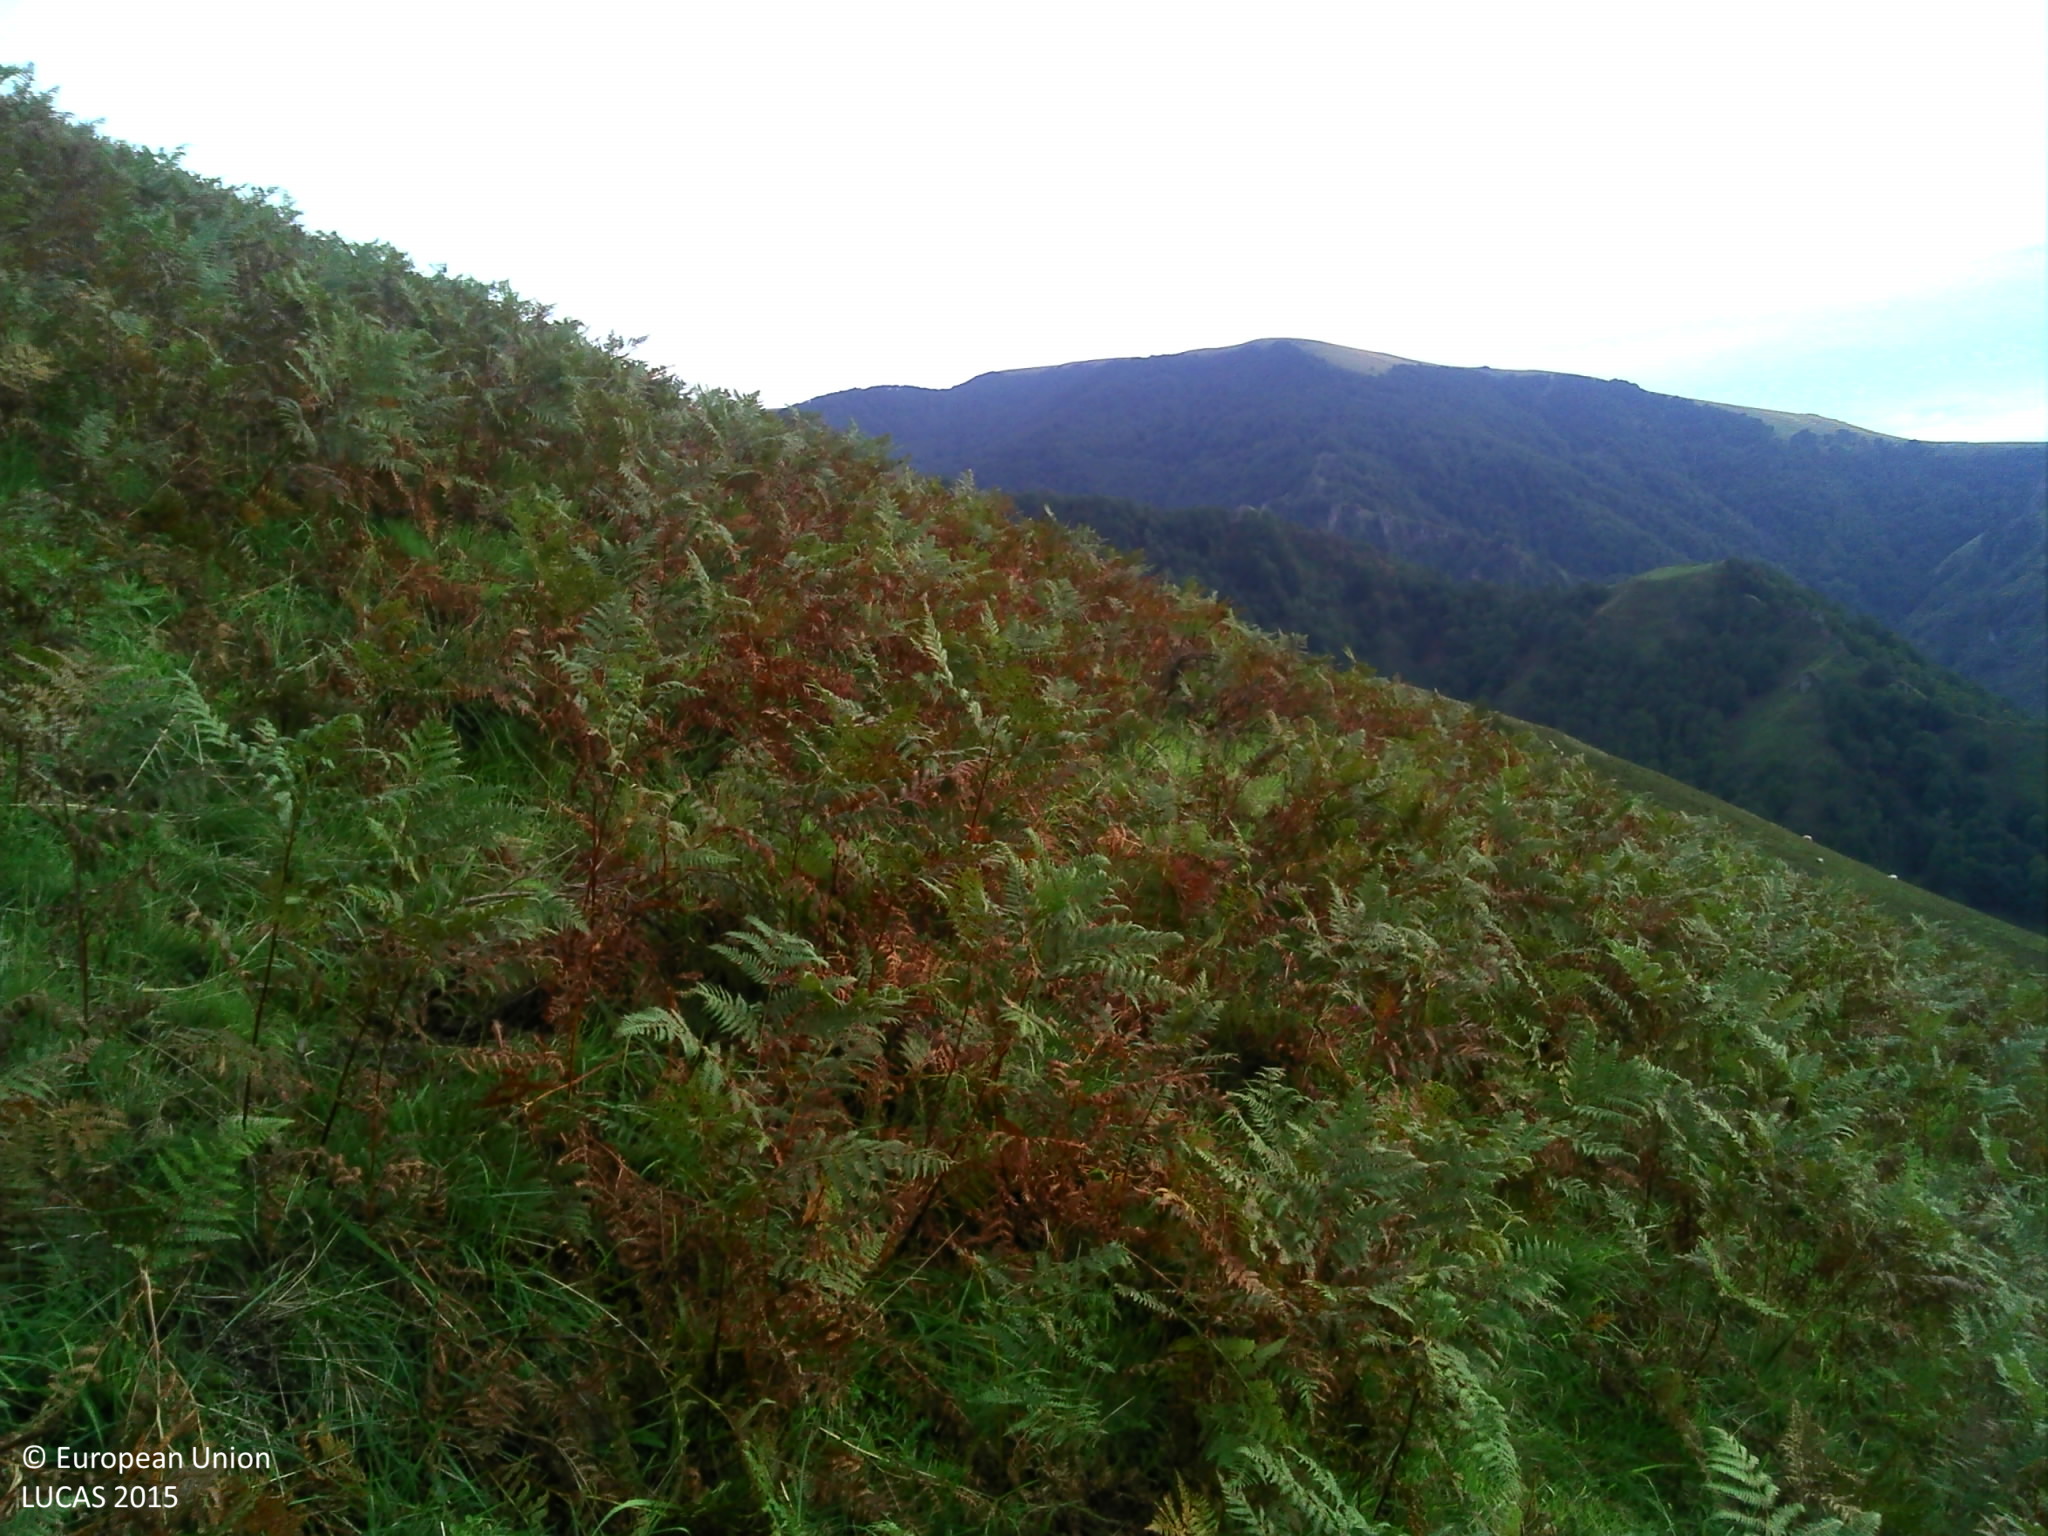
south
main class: Grassland
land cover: Grassland without tree/shrub cover
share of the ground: > 75 %
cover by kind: herbaceous plants 100 %
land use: Agriculture (excluding fallow land and kitchen gardens)
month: September
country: FR
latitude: 43.0795
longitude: -1.1026
